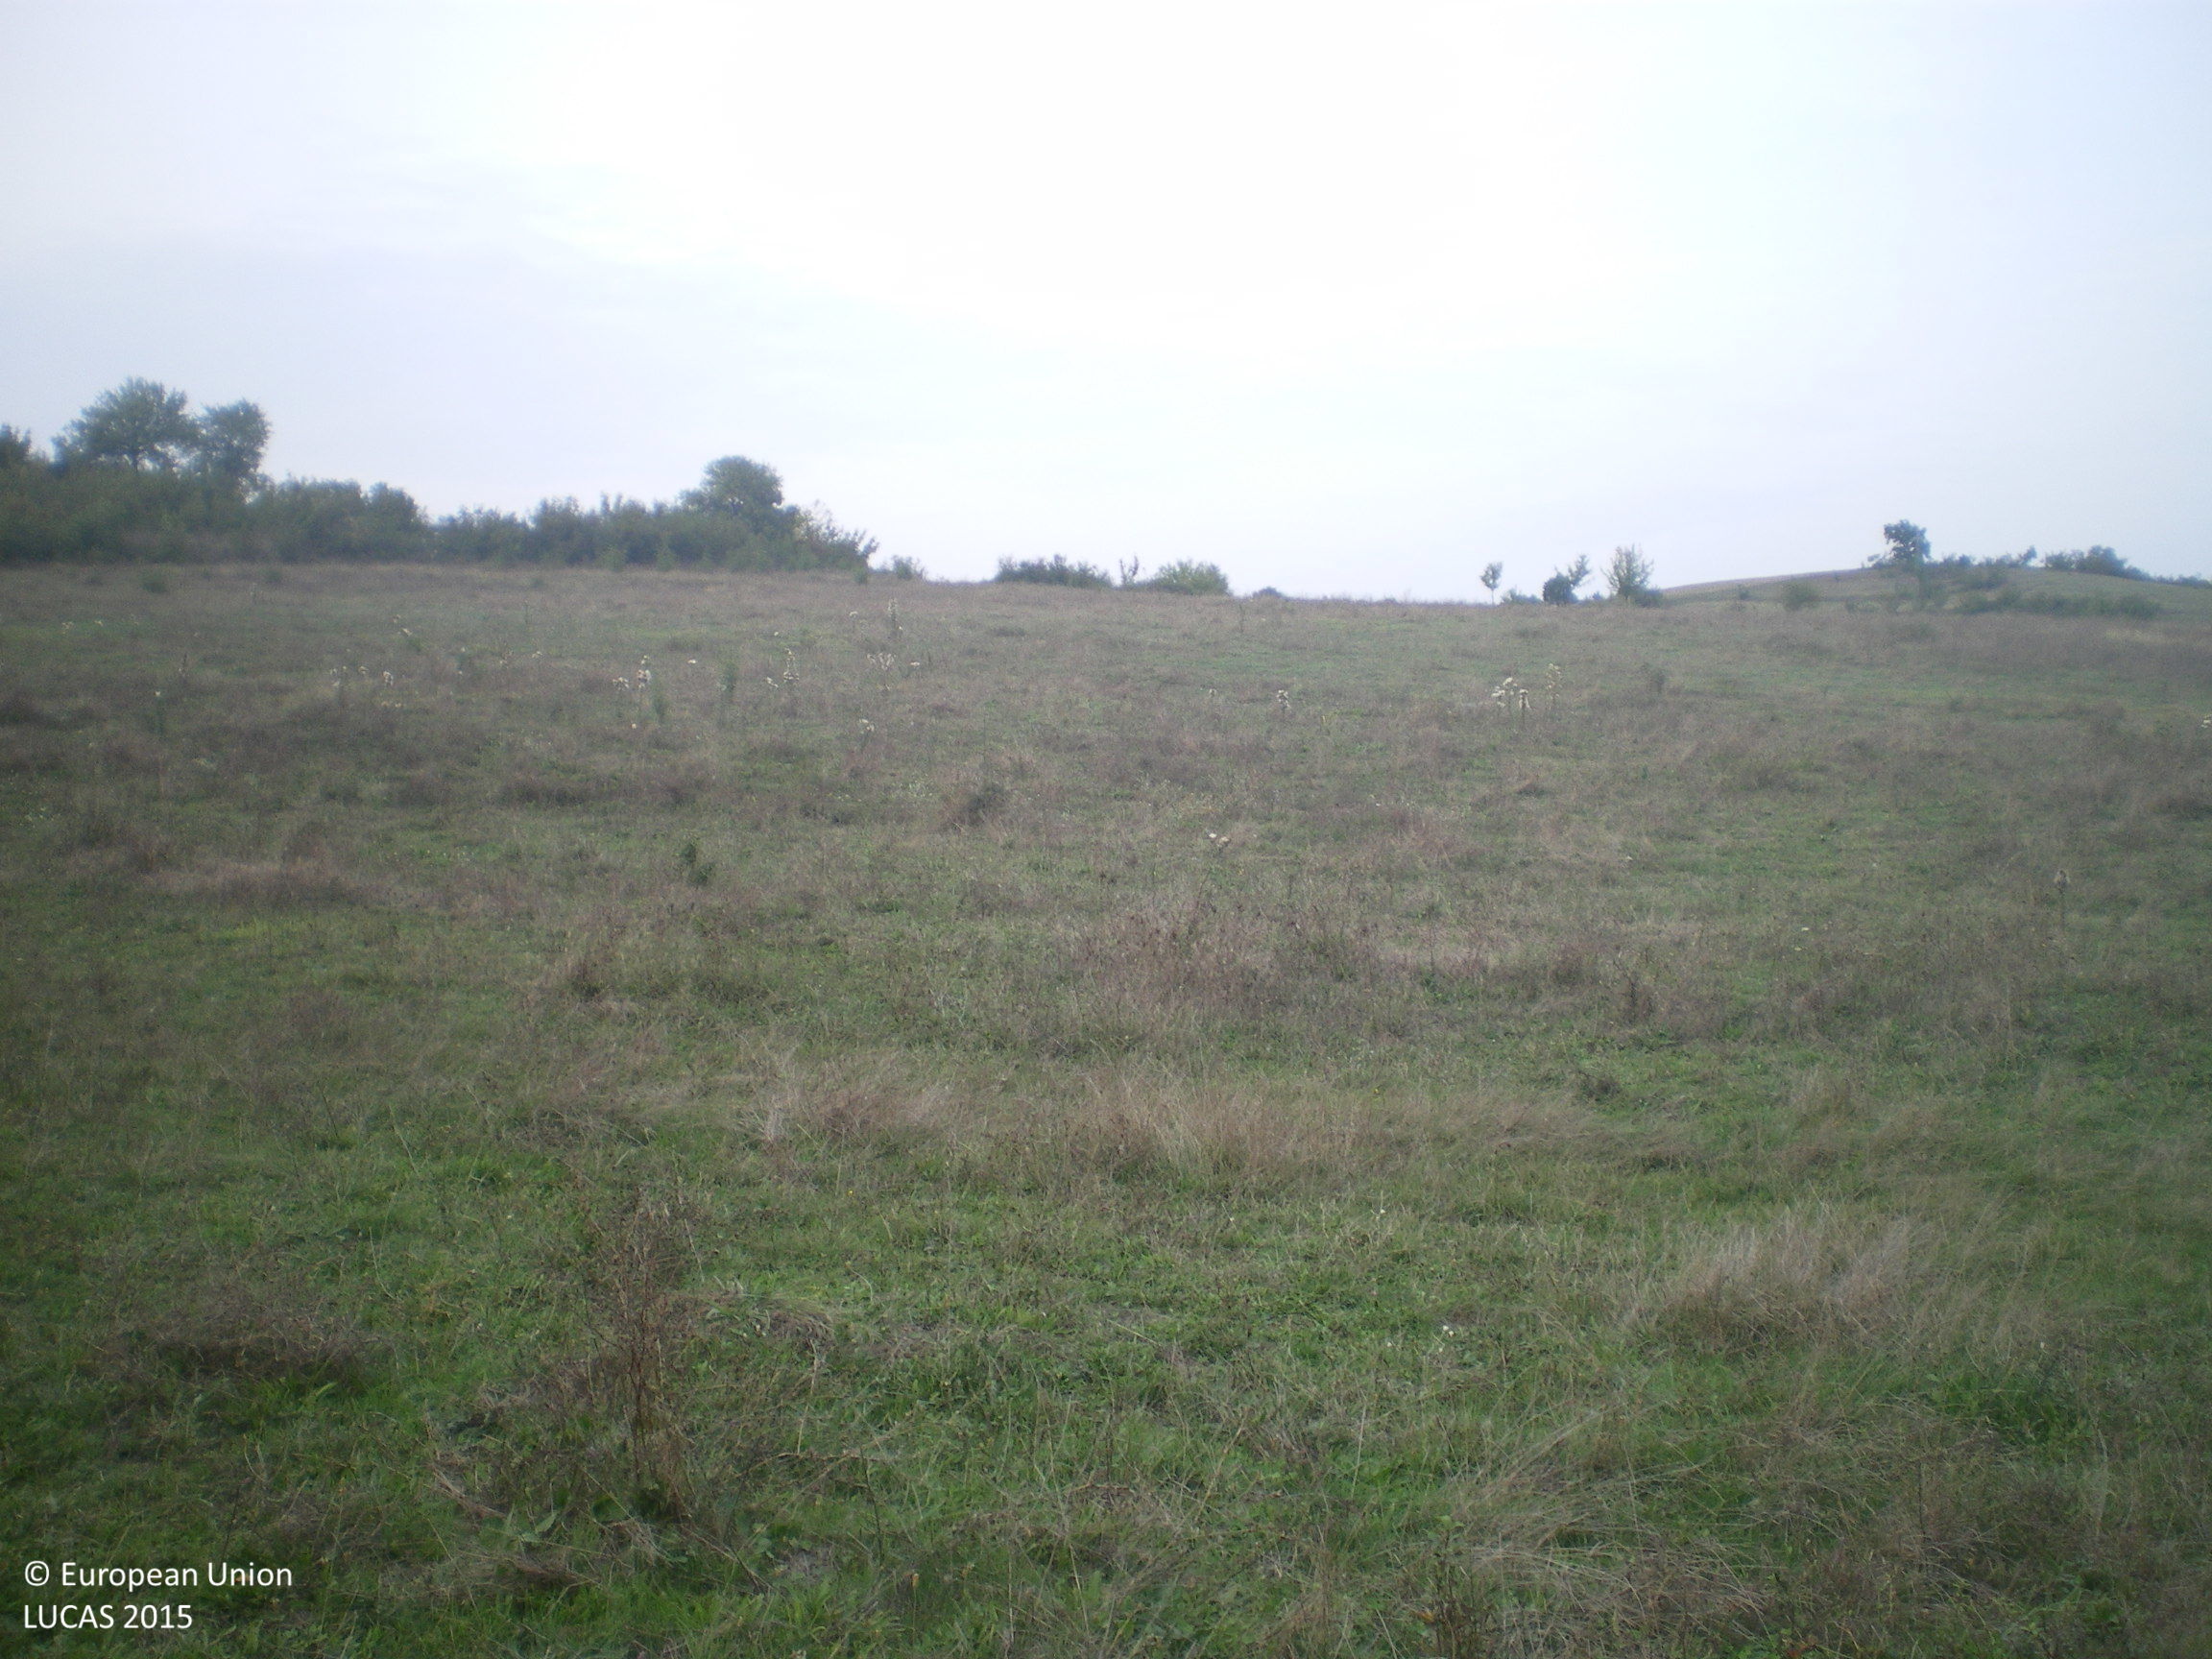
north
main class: Grassland
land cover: Grassland without tree/shrub cover
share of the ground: > 75 %
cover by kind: herbaceous plants 100 %
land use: Agriculture (excluding fallow land and kitchen gardens)
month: September
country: BG
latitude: 41.8467
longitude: 25.9082
